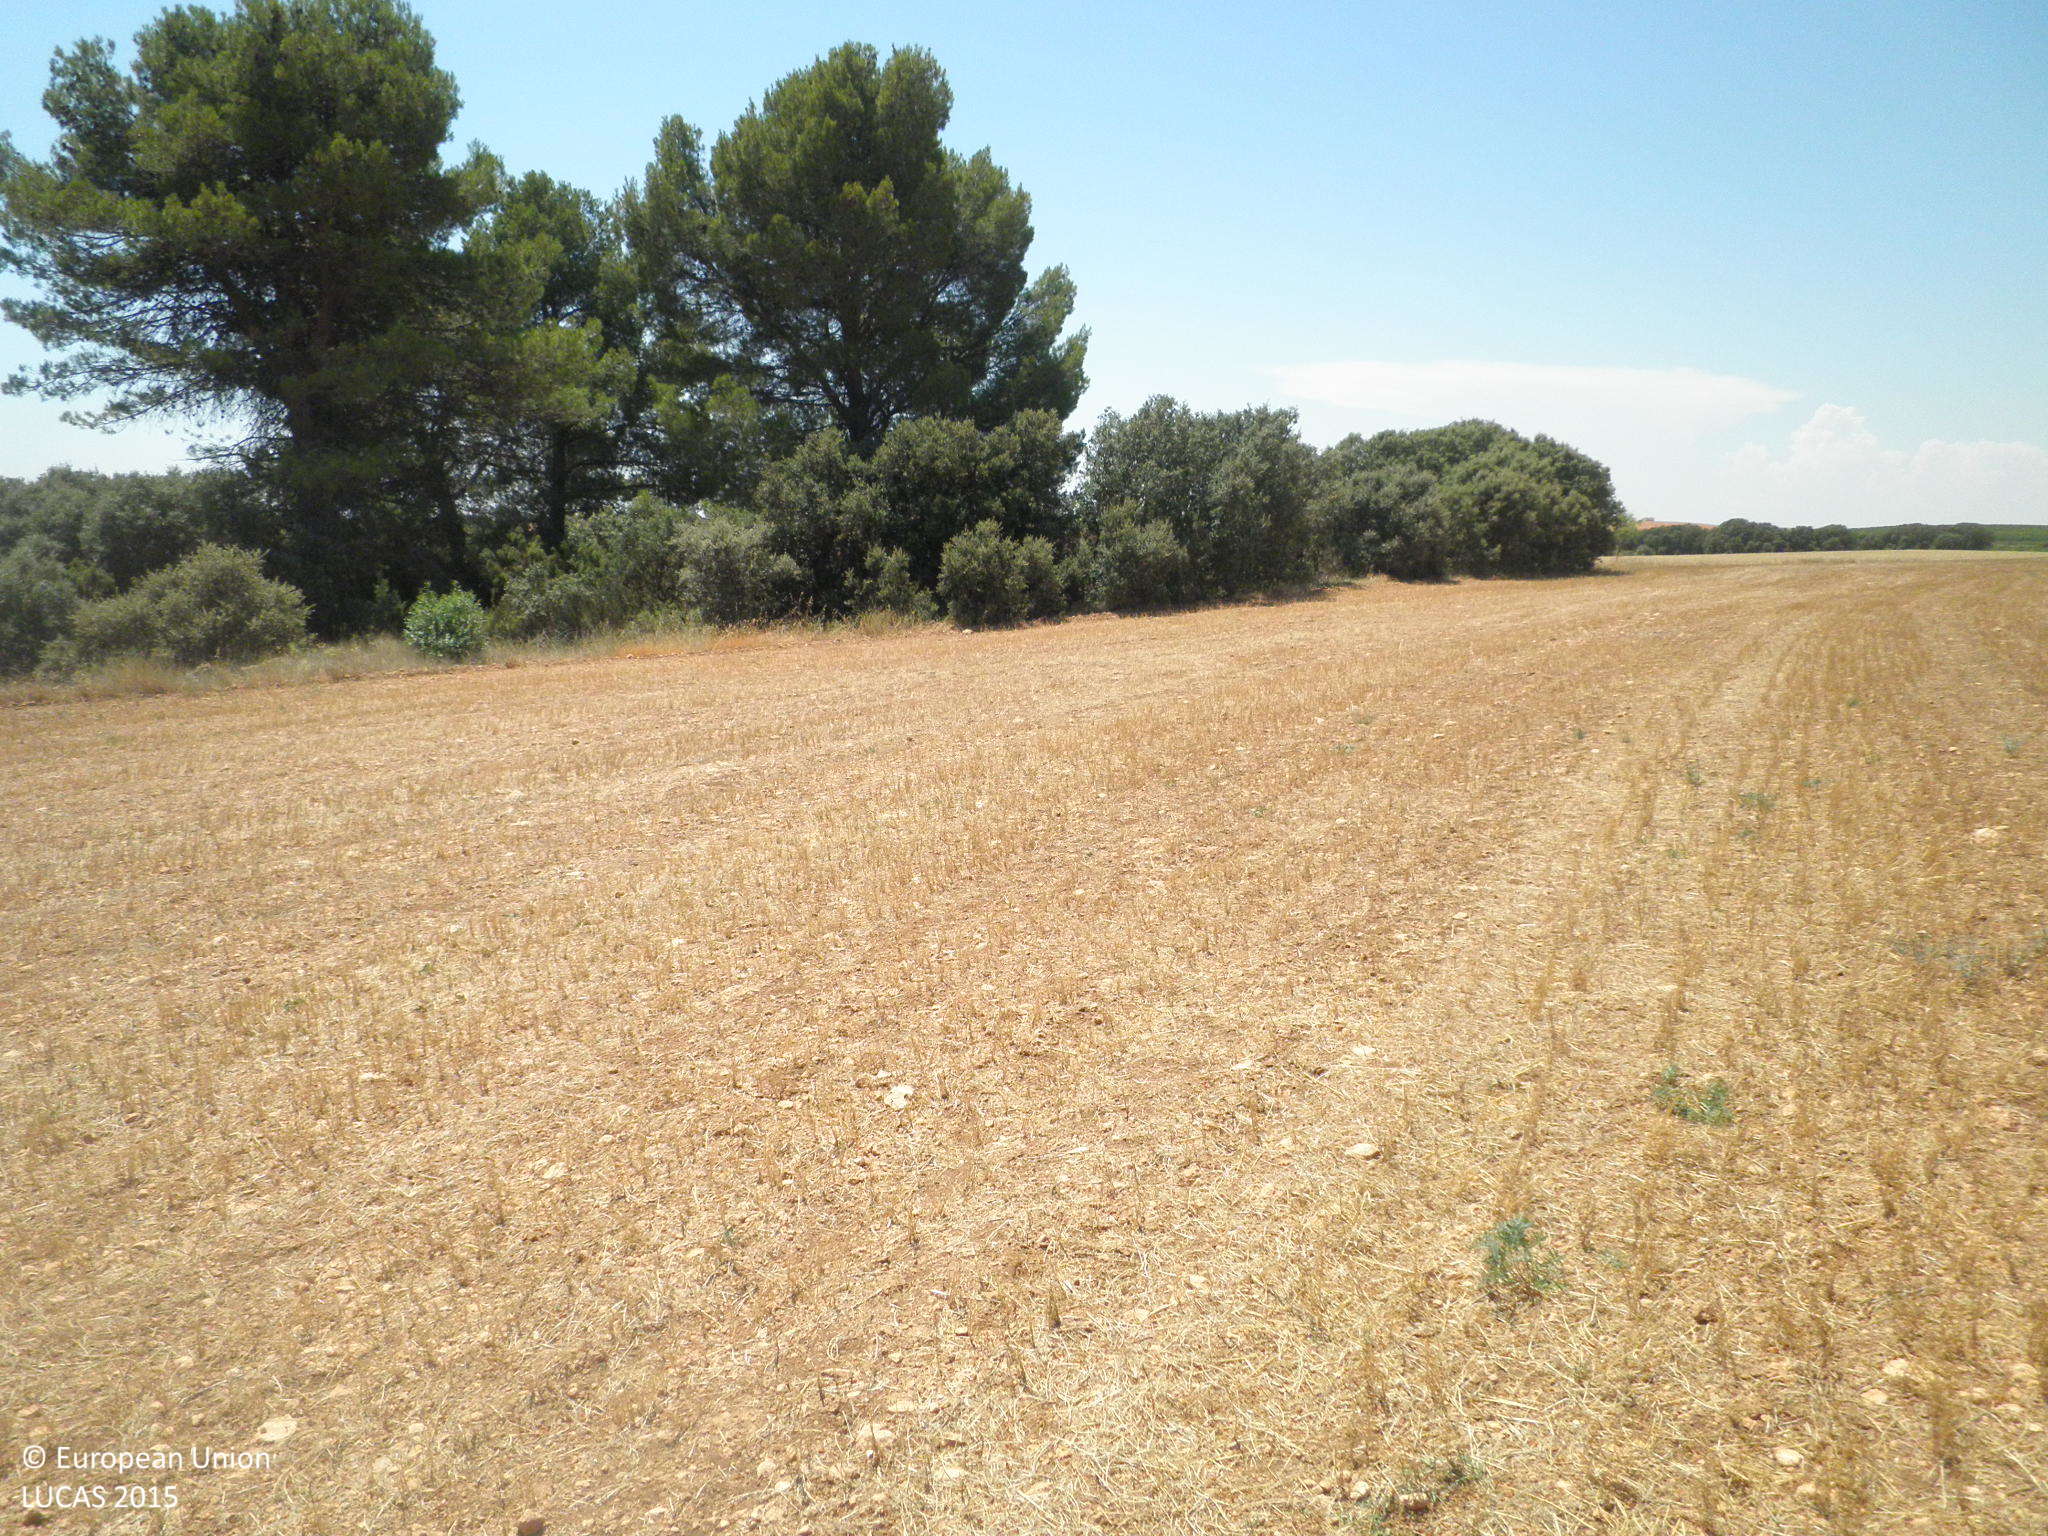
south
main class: Cropland
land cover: Dry pulses
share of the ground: < 10 %
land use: Agriculture (excluding fallow land and kitchen gardens)
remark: Harvested field
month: July
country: ES
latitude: 39.6083
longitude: -1.6417
